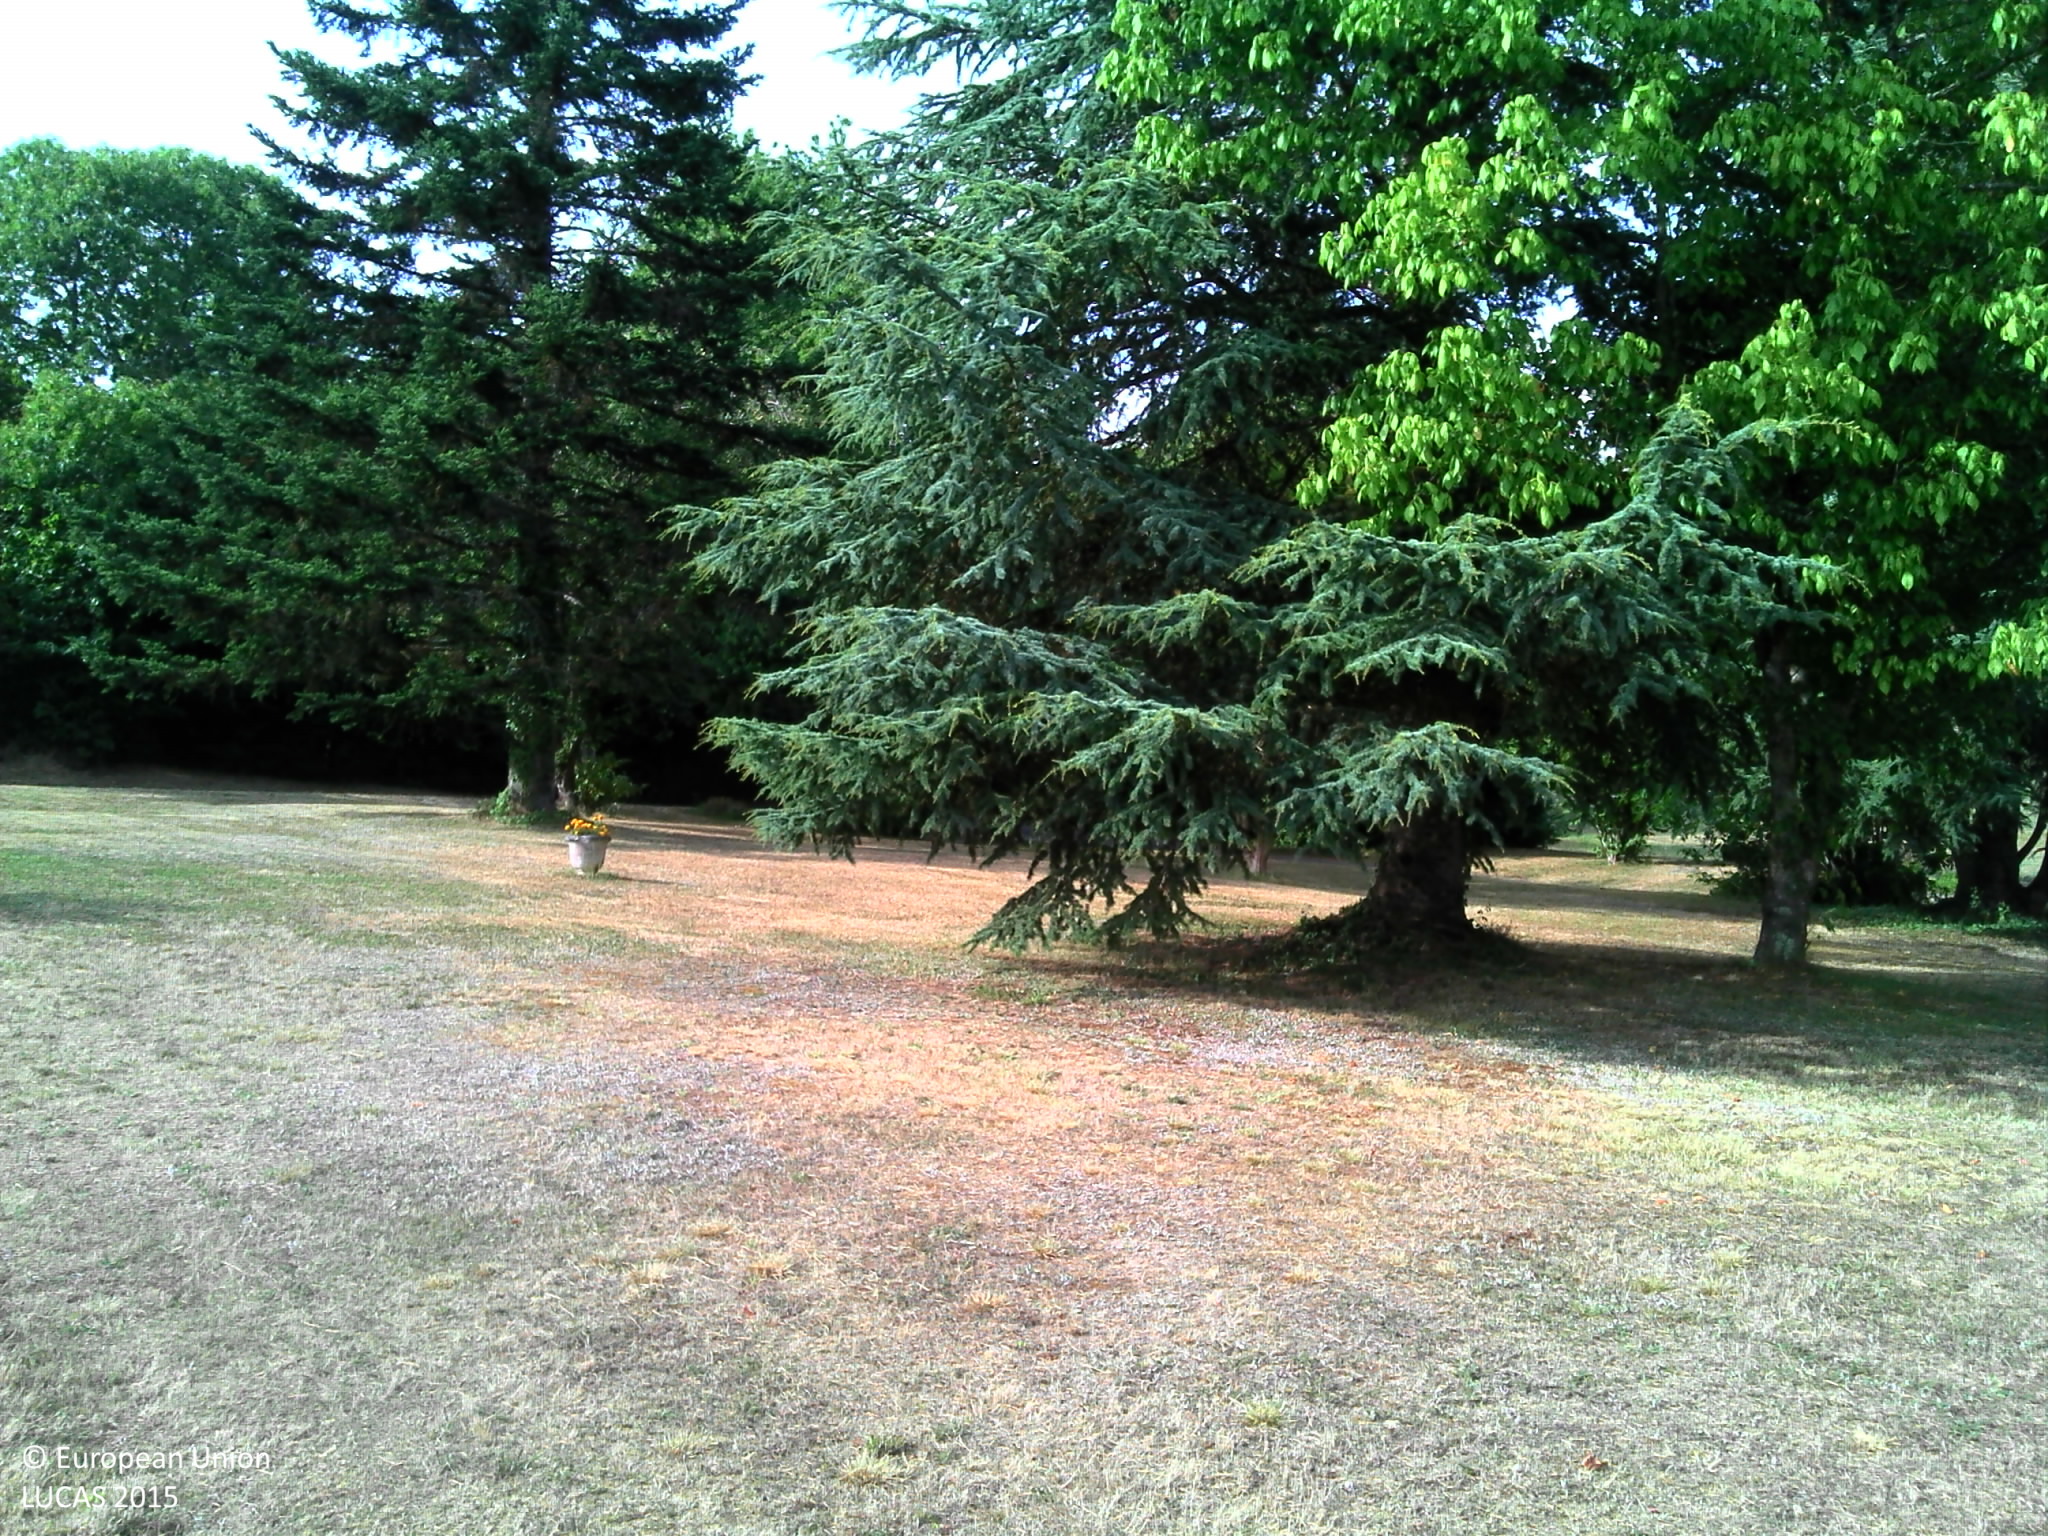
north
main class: Grassland
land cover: Grassland with sparse tree/shrub cover
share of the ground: > 75 %
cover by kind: herbaceous plants 65 %, lichens and mosses 10 %, consolidated bare surface 10 %, broadleaved forest trees 5 %
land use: Residential
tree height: > 5 m
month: July
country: FR
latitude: 45.0418
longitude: 0.5317
